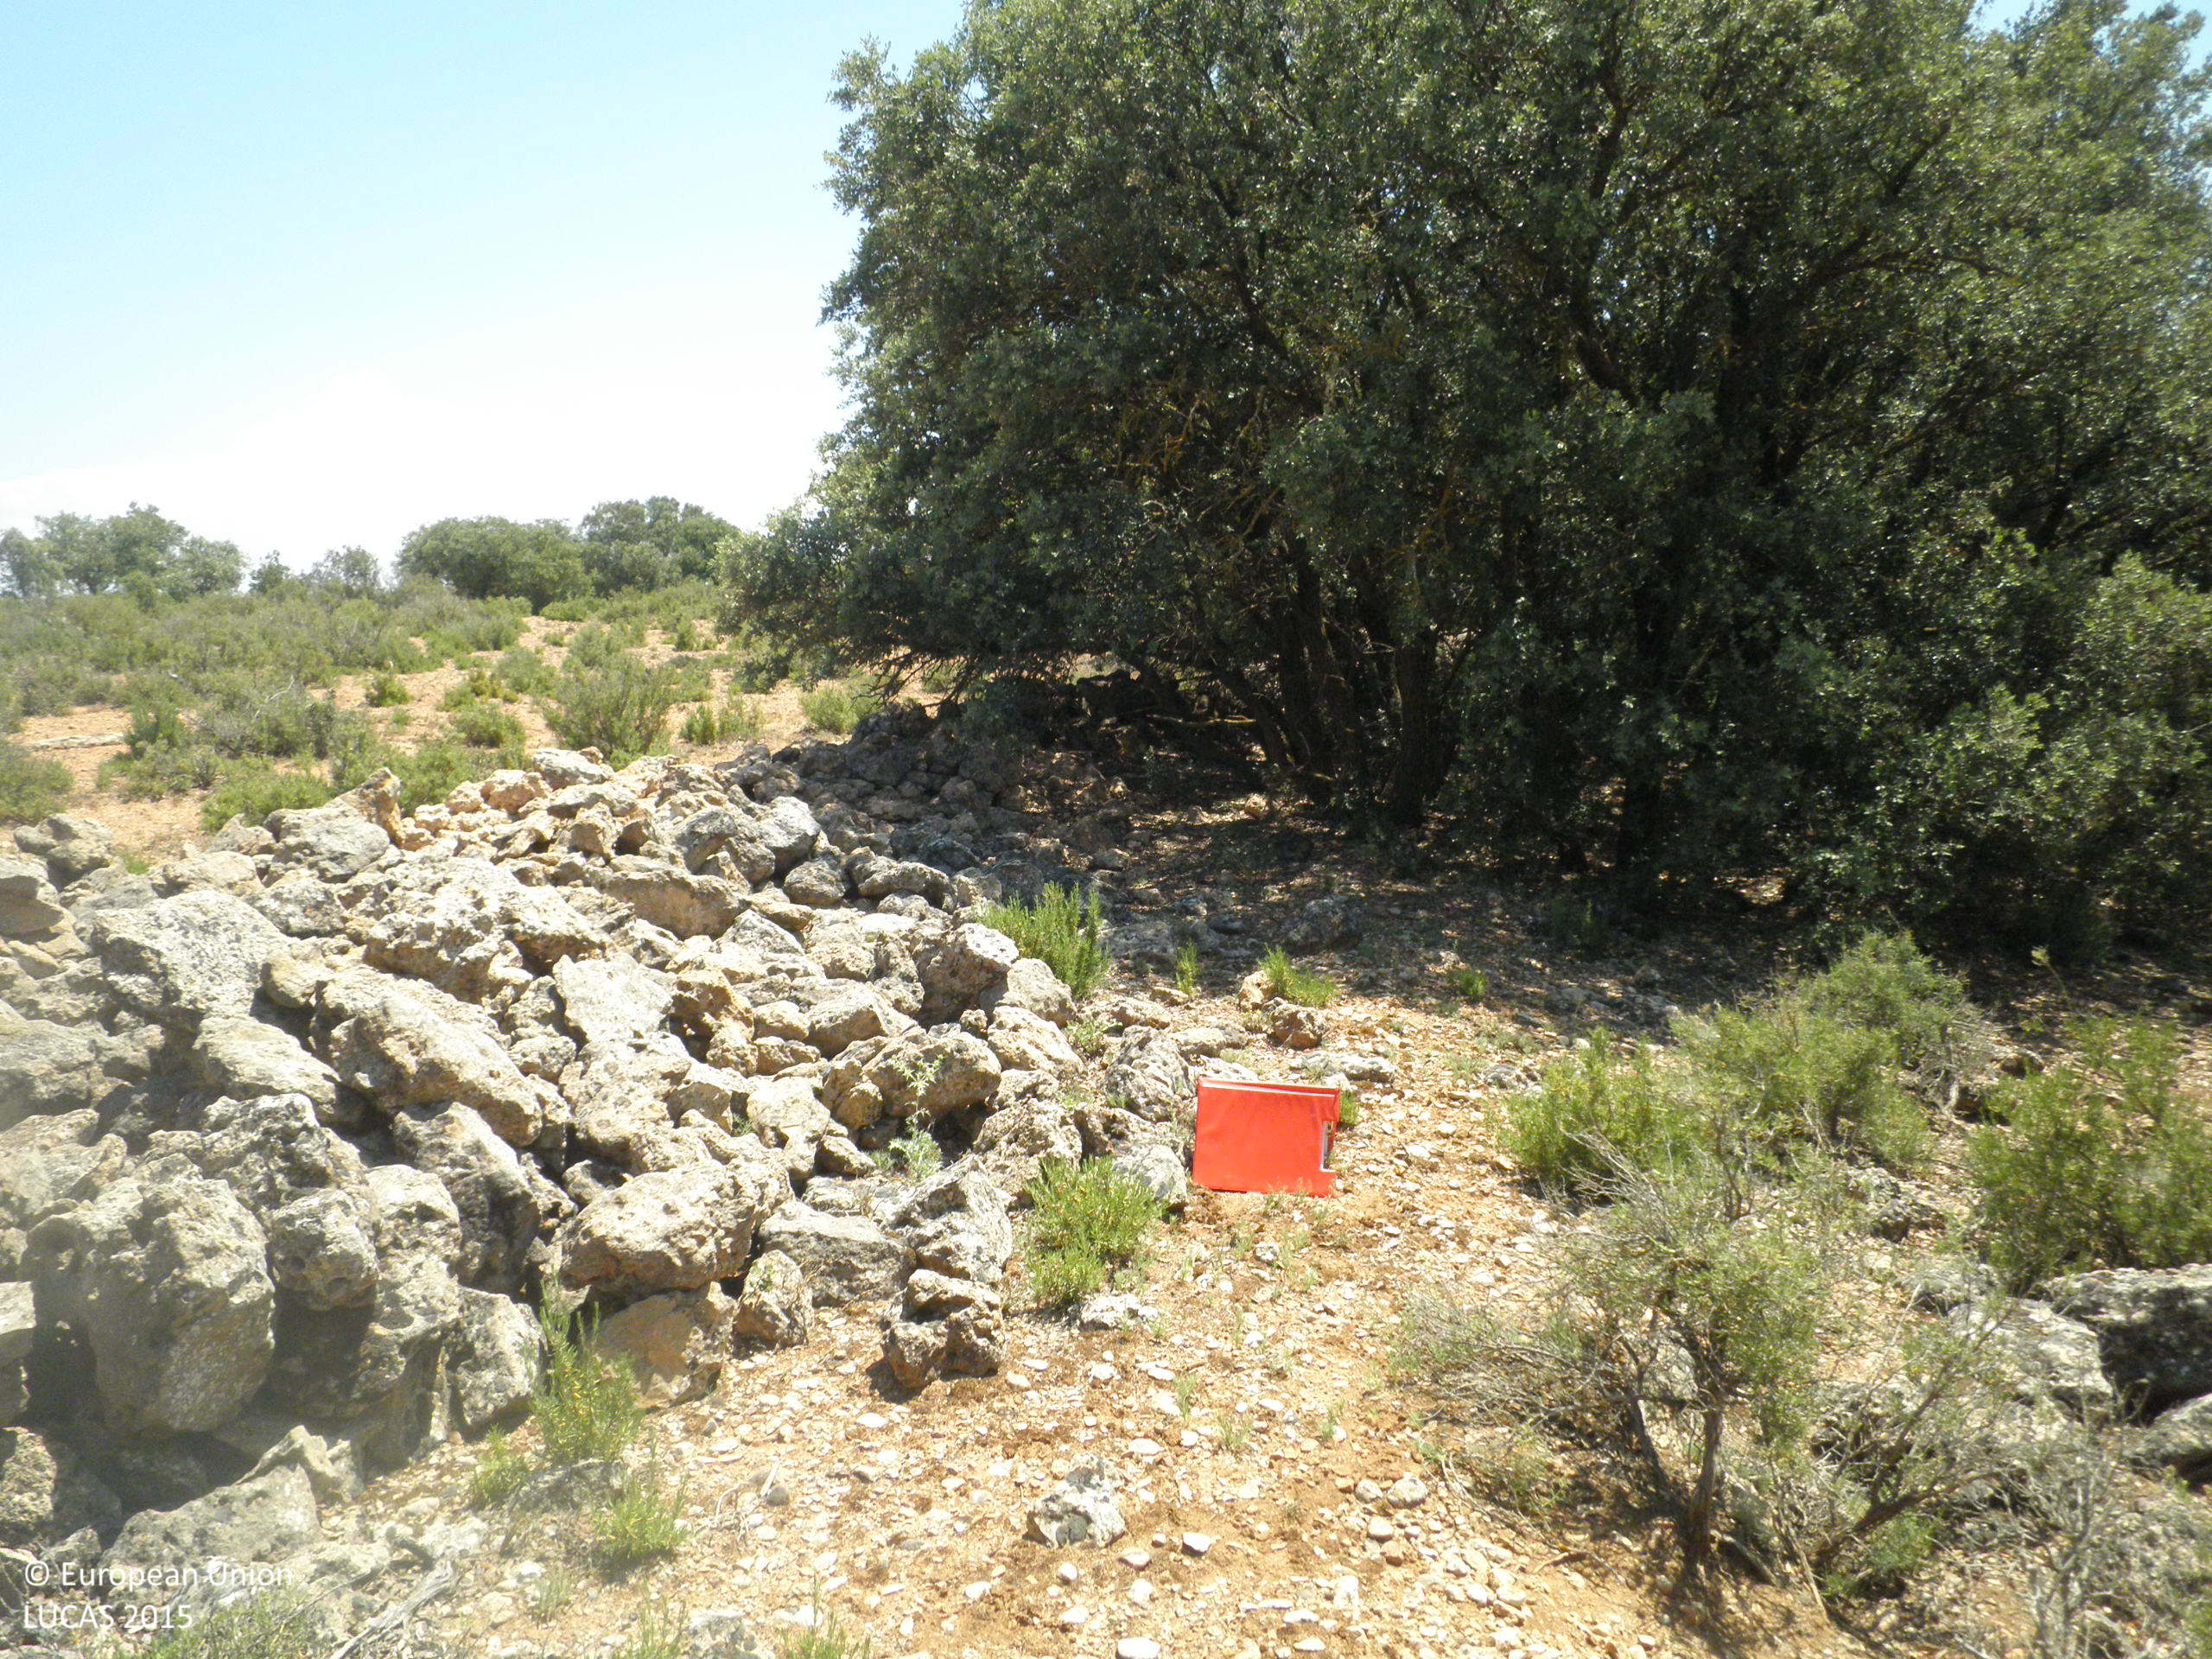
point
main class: Woodland
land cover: Broadleaved woodland
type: broadleaved evergreen forest
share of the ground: 25 - 50 %
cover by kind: unconsolidated bare surface 35 %, shrubs 30 %, broadleaved forest trees 25 %, consolidated bare surface 10 %
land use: Semi-natural and natural areas not in use
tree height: < 5 m
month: June
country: ES
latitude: 39.4900
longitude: -1.7141
